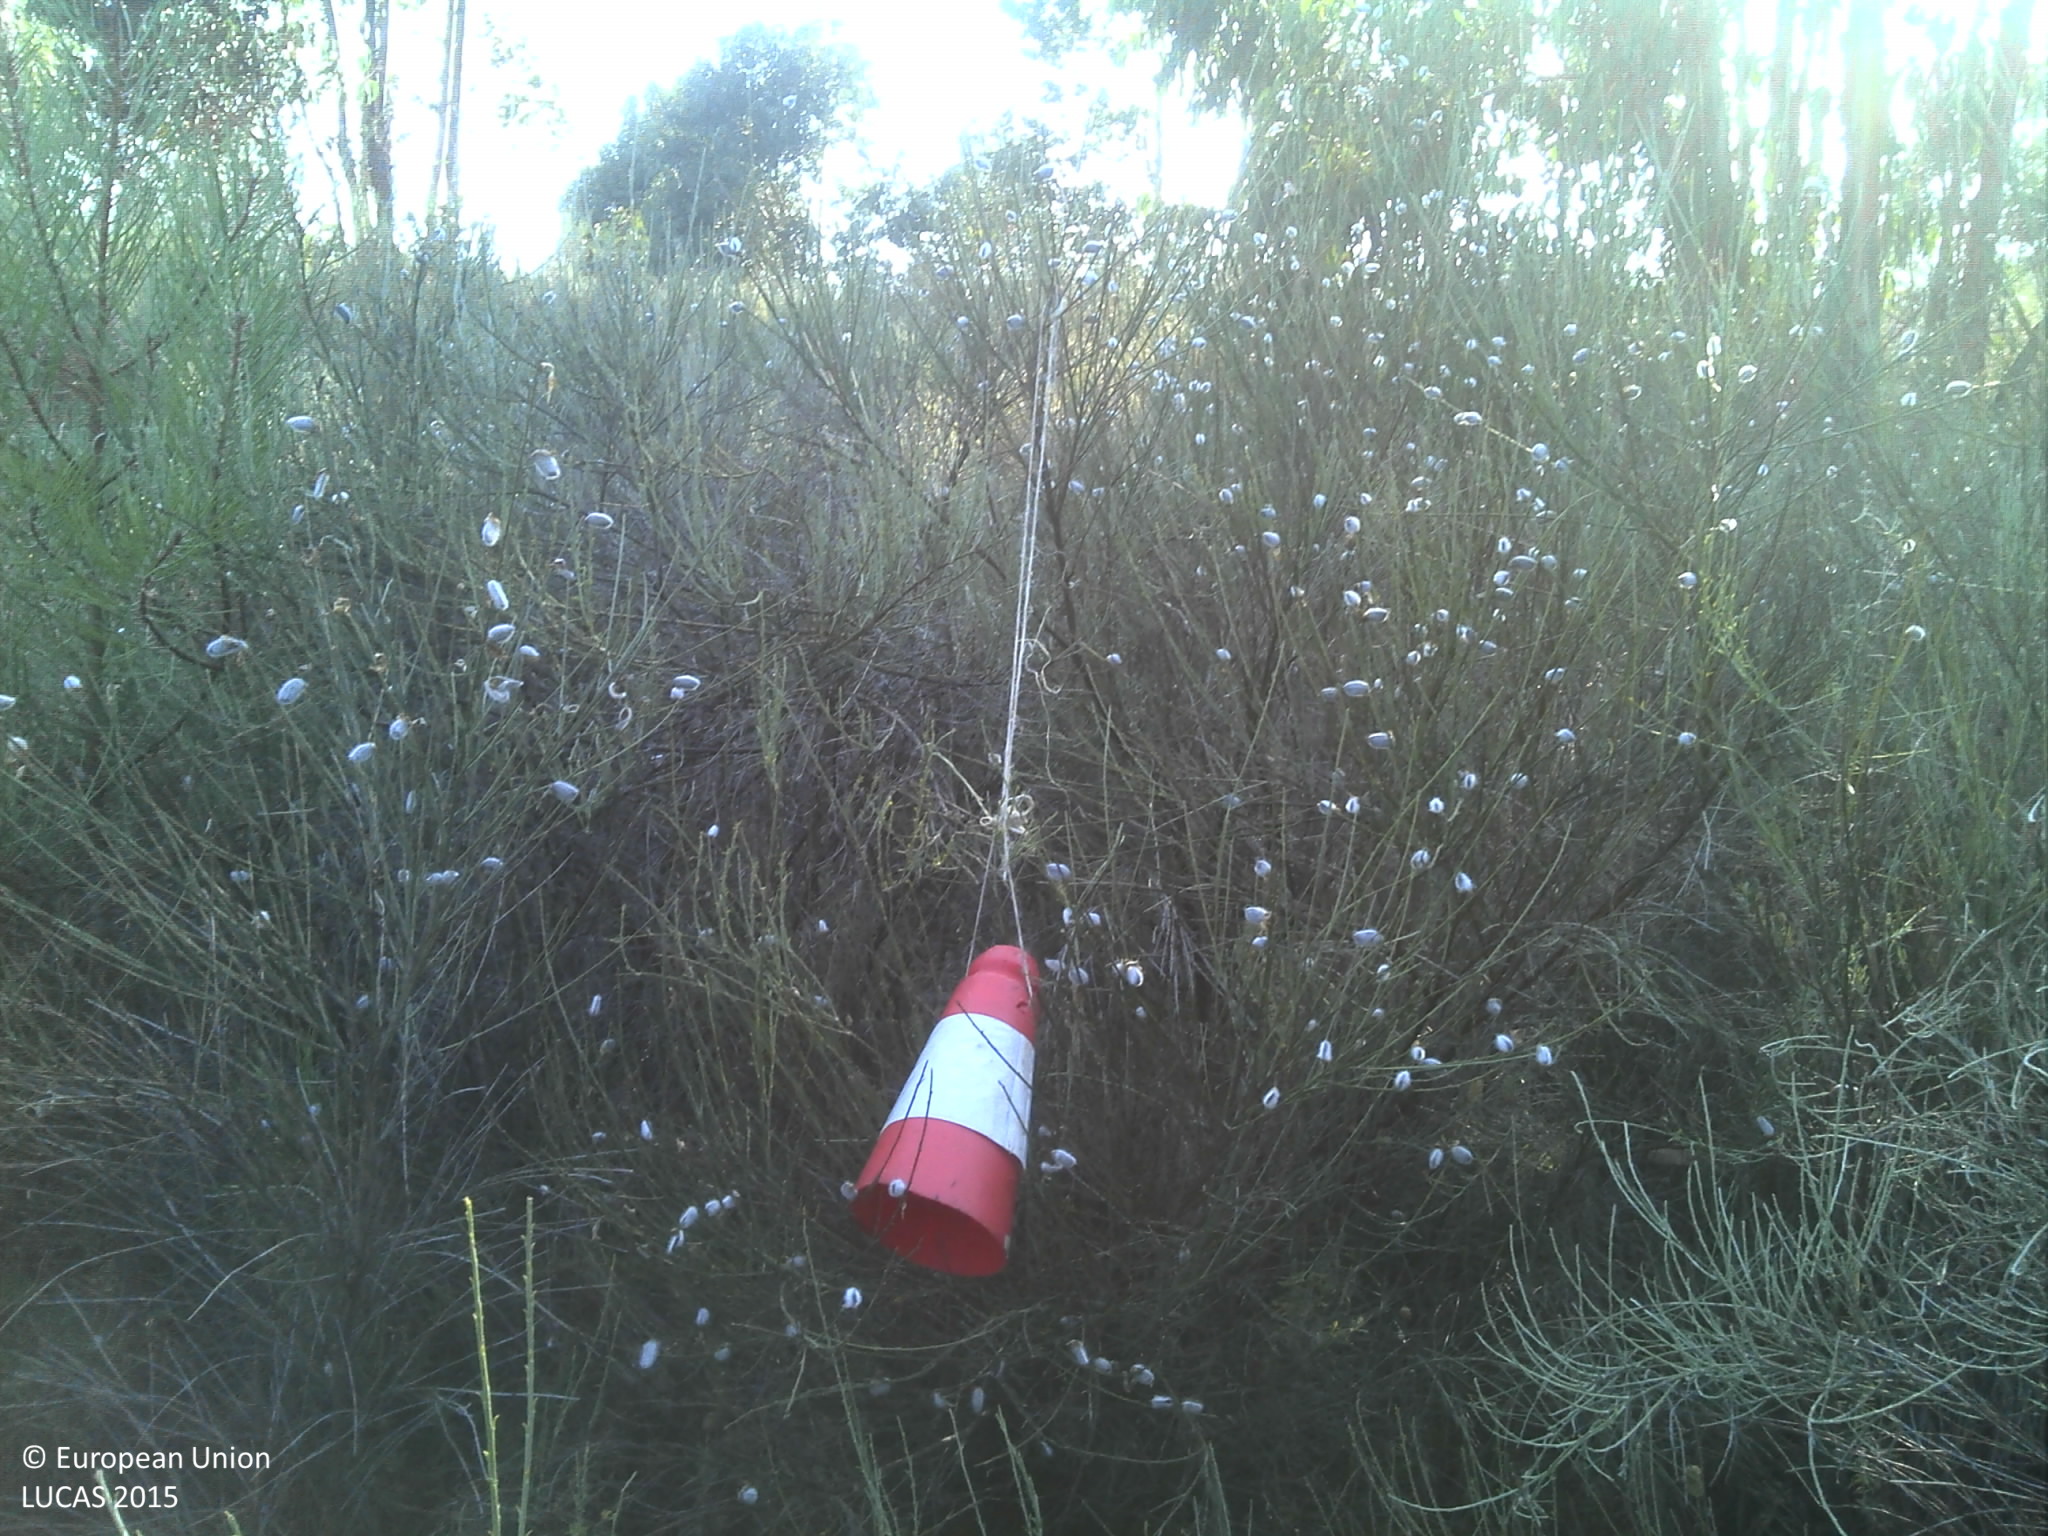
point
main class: Woodland
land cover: Broadleaved woodland
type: exotic forest
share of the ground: 25 - 50 %
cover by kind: broadleaved forest trees 50 %, shrubs 35 %, unconsolidated bare surface 10 %
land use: Forestry
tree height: > 5 m
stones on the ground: 10 - 25 %
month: June
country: PT
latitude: 39.9074
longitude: -7.3509
